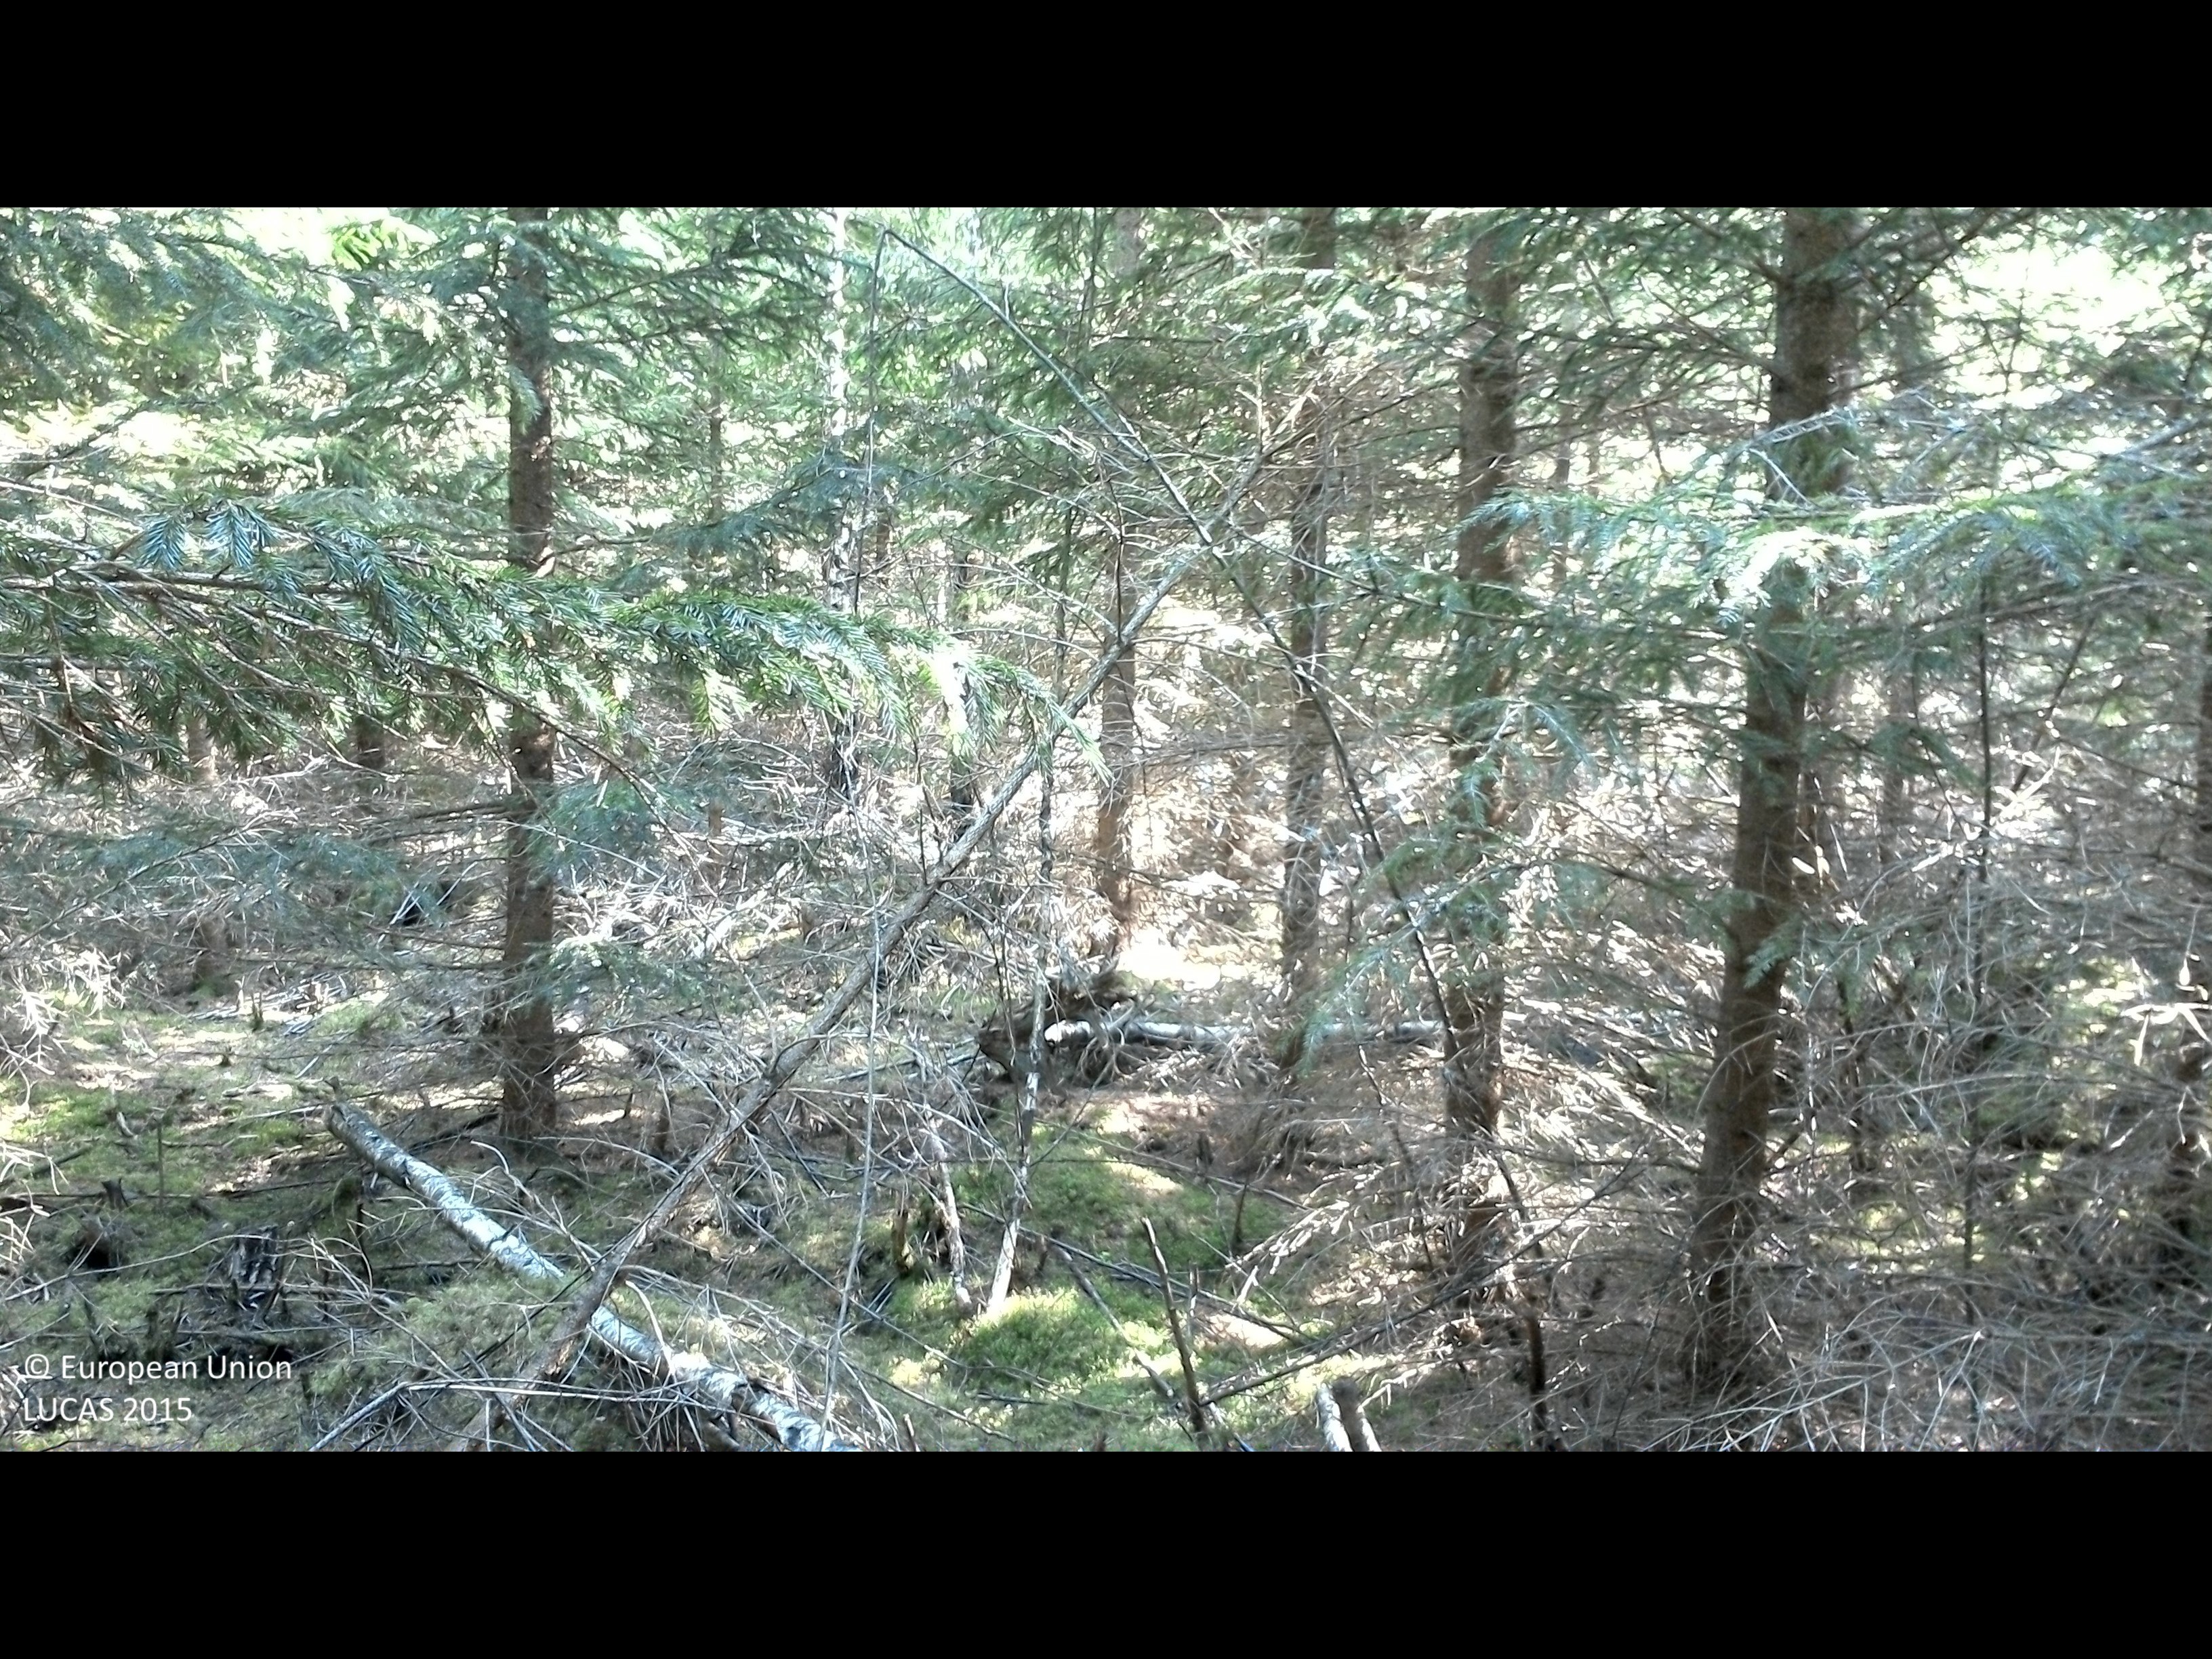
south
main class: Woodland
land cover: Spruce dominated coniferous woodland
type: boreal forest
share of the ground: > 75 %
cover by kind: coniferous forest trees 90 %, lichens and mosses 10 %
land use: Forestry
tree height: > 5 m
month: July
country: SE
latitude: 56.4285
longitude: 15.1061
